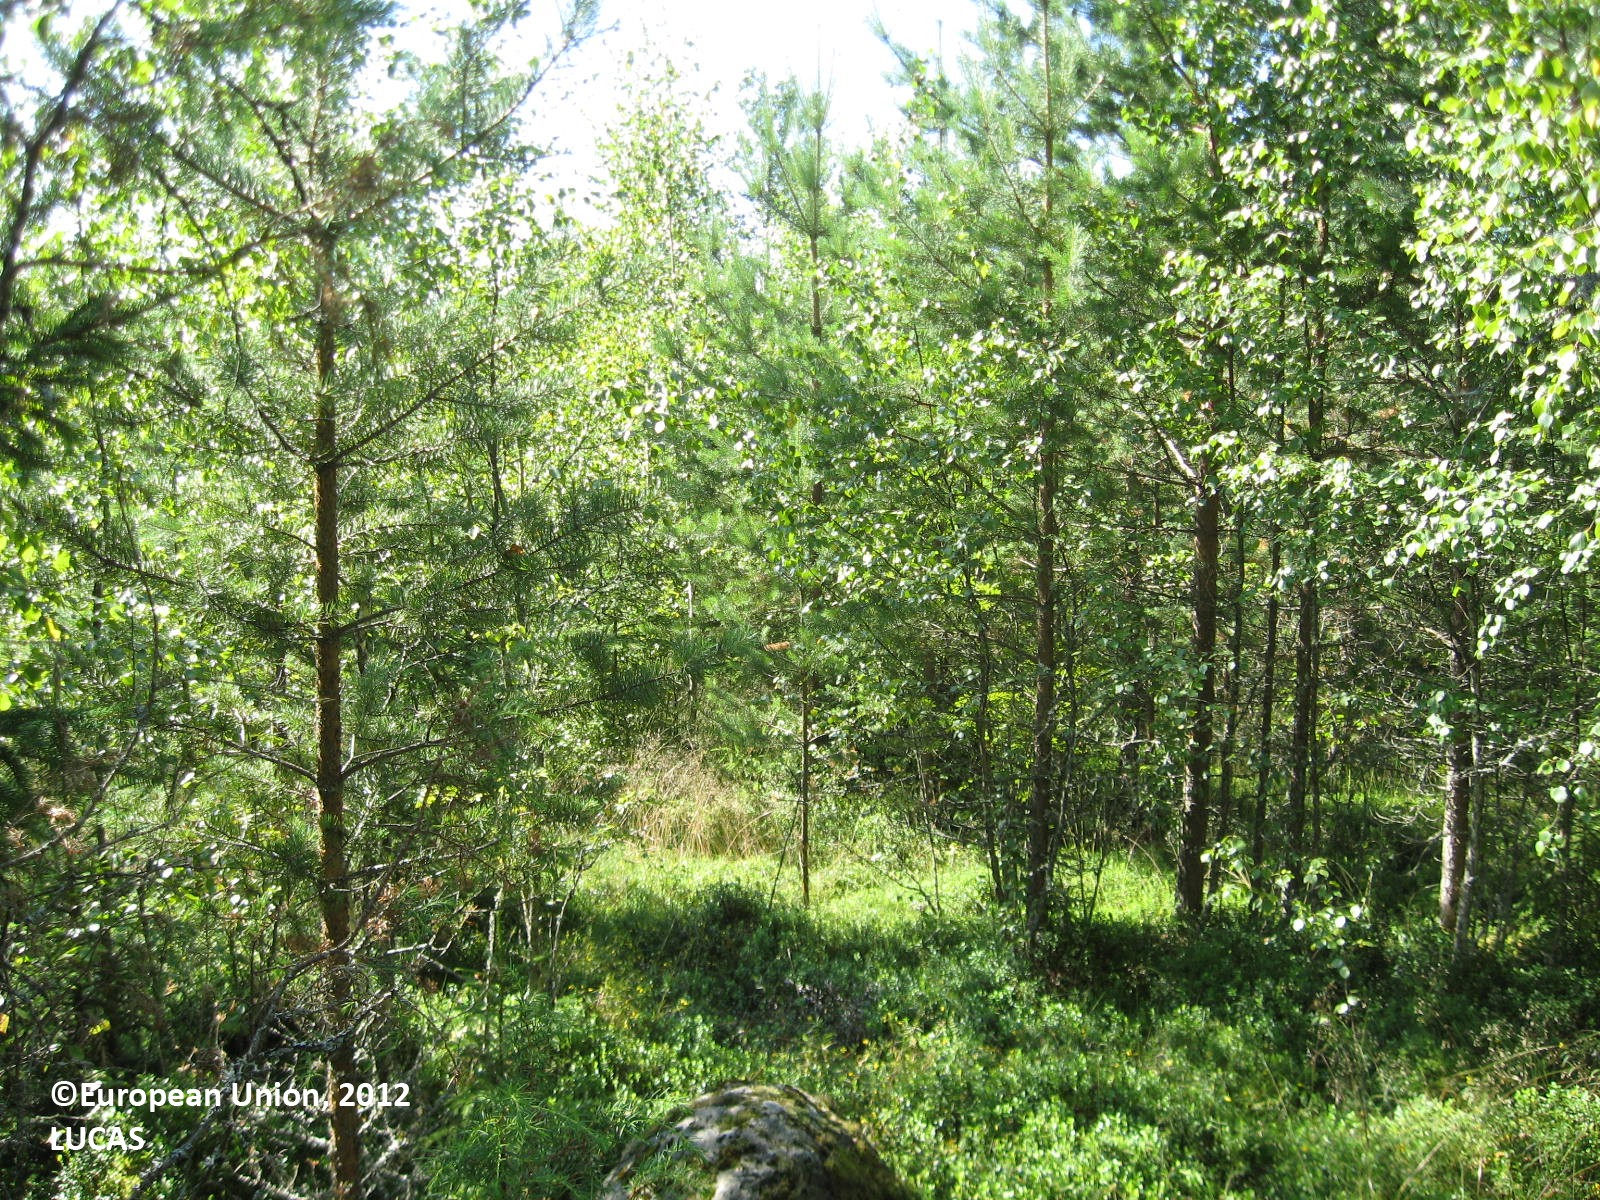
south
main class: Woodland
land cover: Other mixed woodland
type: boreal forest
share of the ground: > 75 %
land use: Forestry
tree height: > 5 m
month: July
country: FI
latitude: 61.8652
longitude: 22.5509
